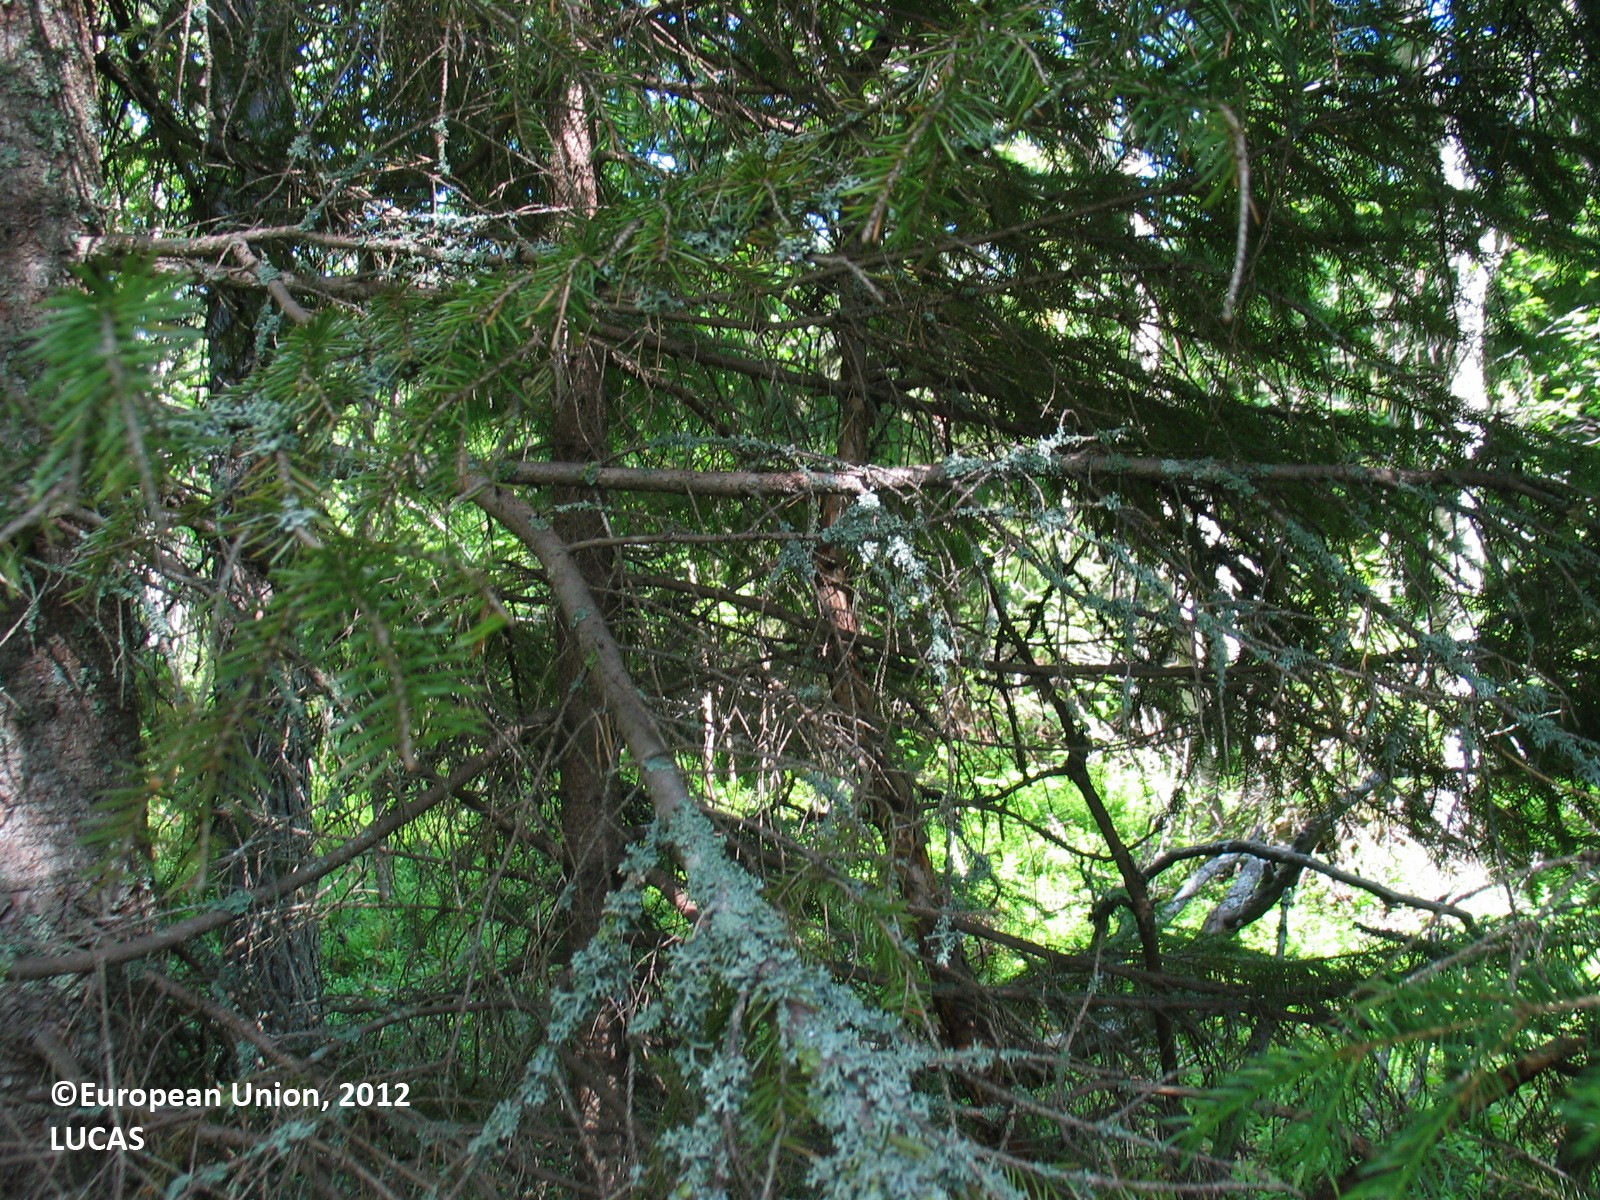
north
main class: Woodland
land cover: Pine dominated coniferous woodland
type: mire and swamp forests
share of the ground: 50 - 75 %
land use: Forestry
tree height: > 5 m
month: July
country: FI
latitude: 65.8180
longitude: 25.0500
